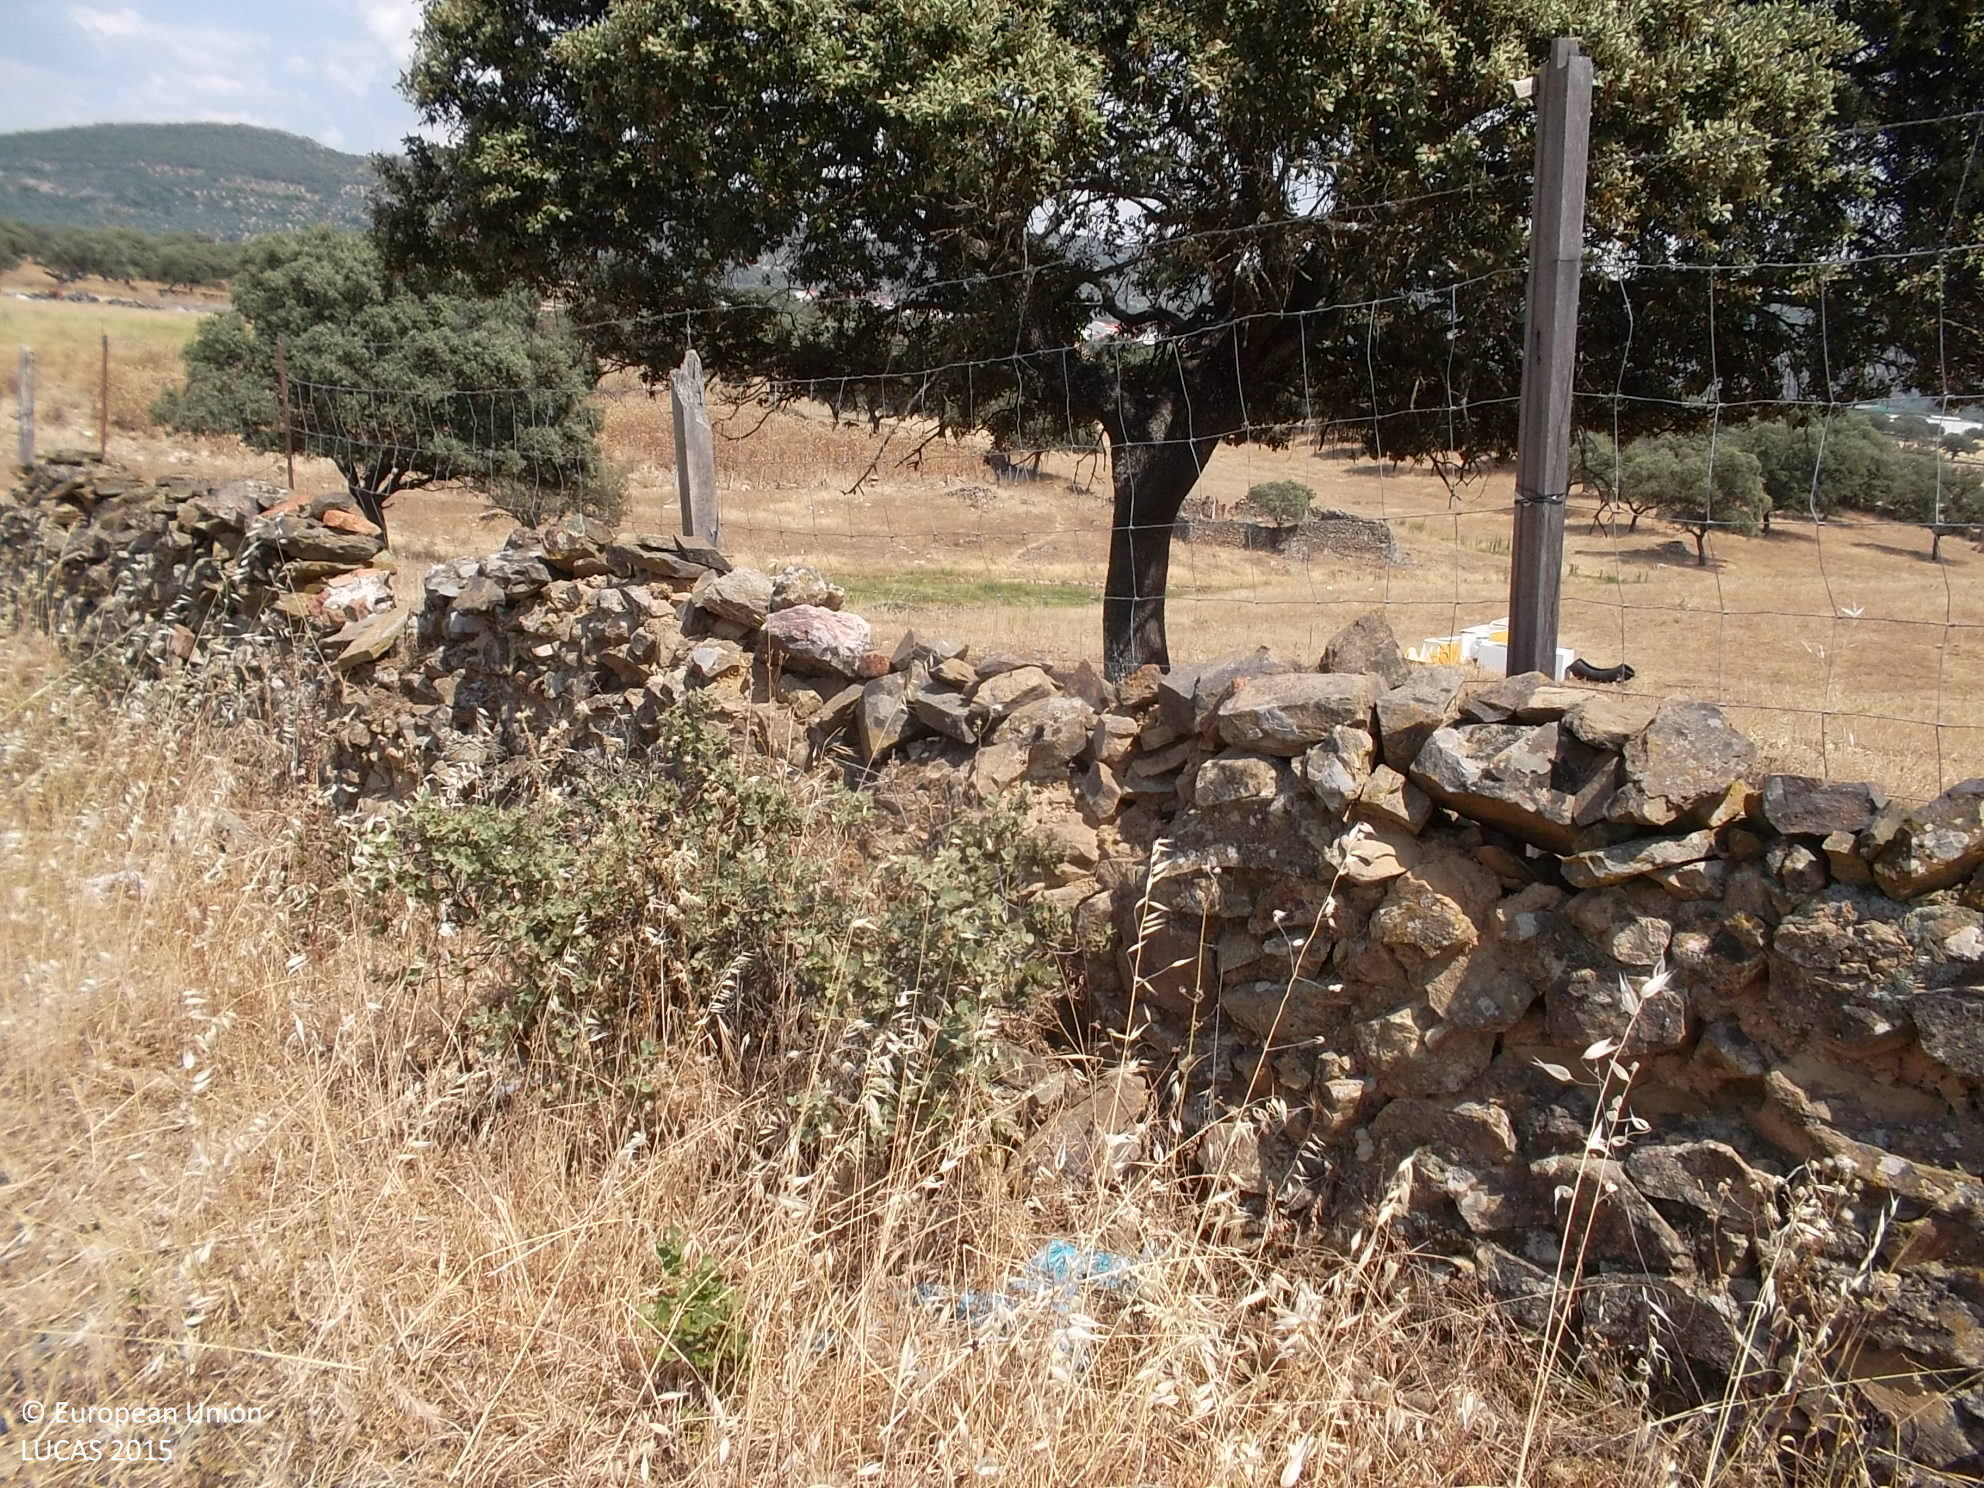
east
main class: Woodland
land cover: Broadleaved woodland
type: broadleaved evergreen forest
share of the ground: 25 - 50 %
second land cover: Spontaneously vegetated surfaces
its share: > 75 %
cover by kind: herbaceous plants 60 %, broadleaved forest trees 30 %, shrubs 10 %
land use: Forestry
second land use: Agriculture (excluding fallow land and kitchen gardens)
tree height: > 5 m
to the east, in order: Broadleaved woodland; Spontaneously vegetated surfaces; Rivers and streams; Grassland without tree/shrub cover; Dry stone walls; Broadleaved woodland; Grassland with sparse tree/shrub cover
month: June
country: ES
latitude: 39.1332
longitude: -4.9487
